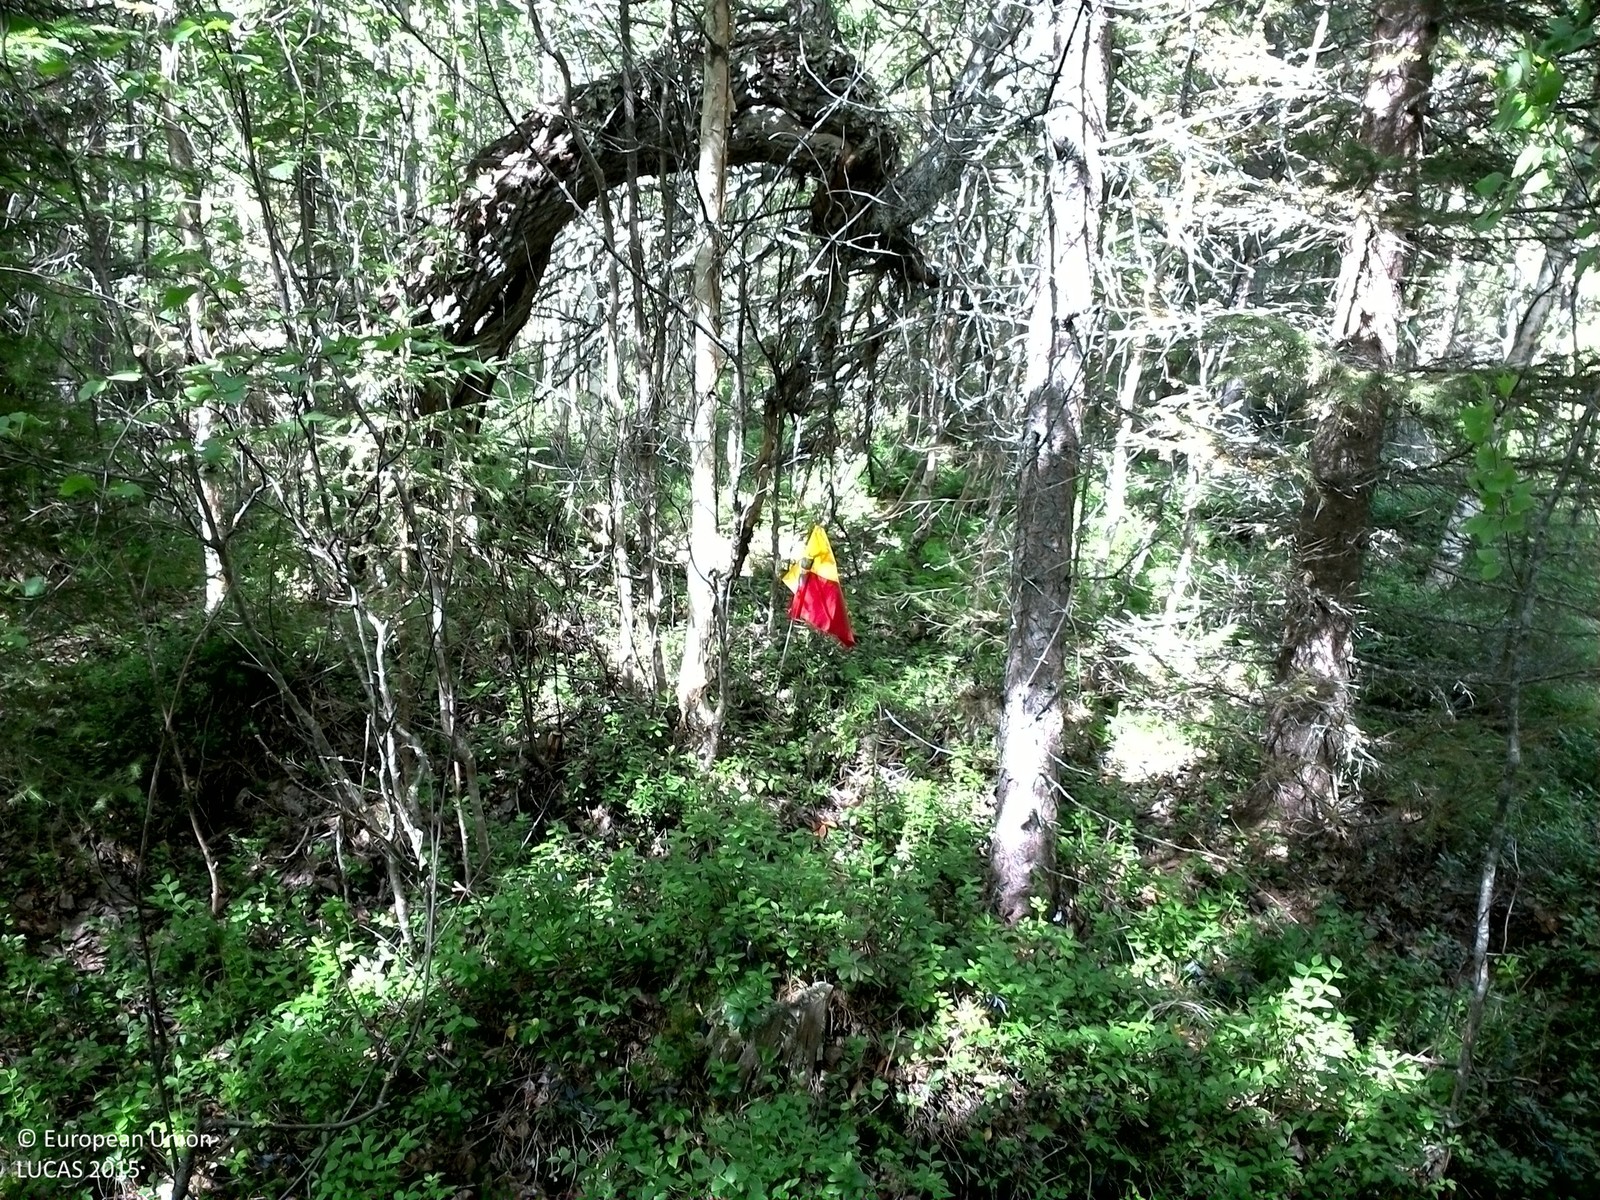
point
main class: Woodland
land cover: Spruce dominated mixed woodland
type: boreal forest
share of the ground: > 75 %
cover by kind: coniferous forest trees 45 %, broadleaved forest trees 35 %, shrubs 10 %, herbaceous plants 10 %
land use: Forestry
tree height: > 5 m
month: August
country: SE
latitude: 63.7568
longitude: 16.5195
